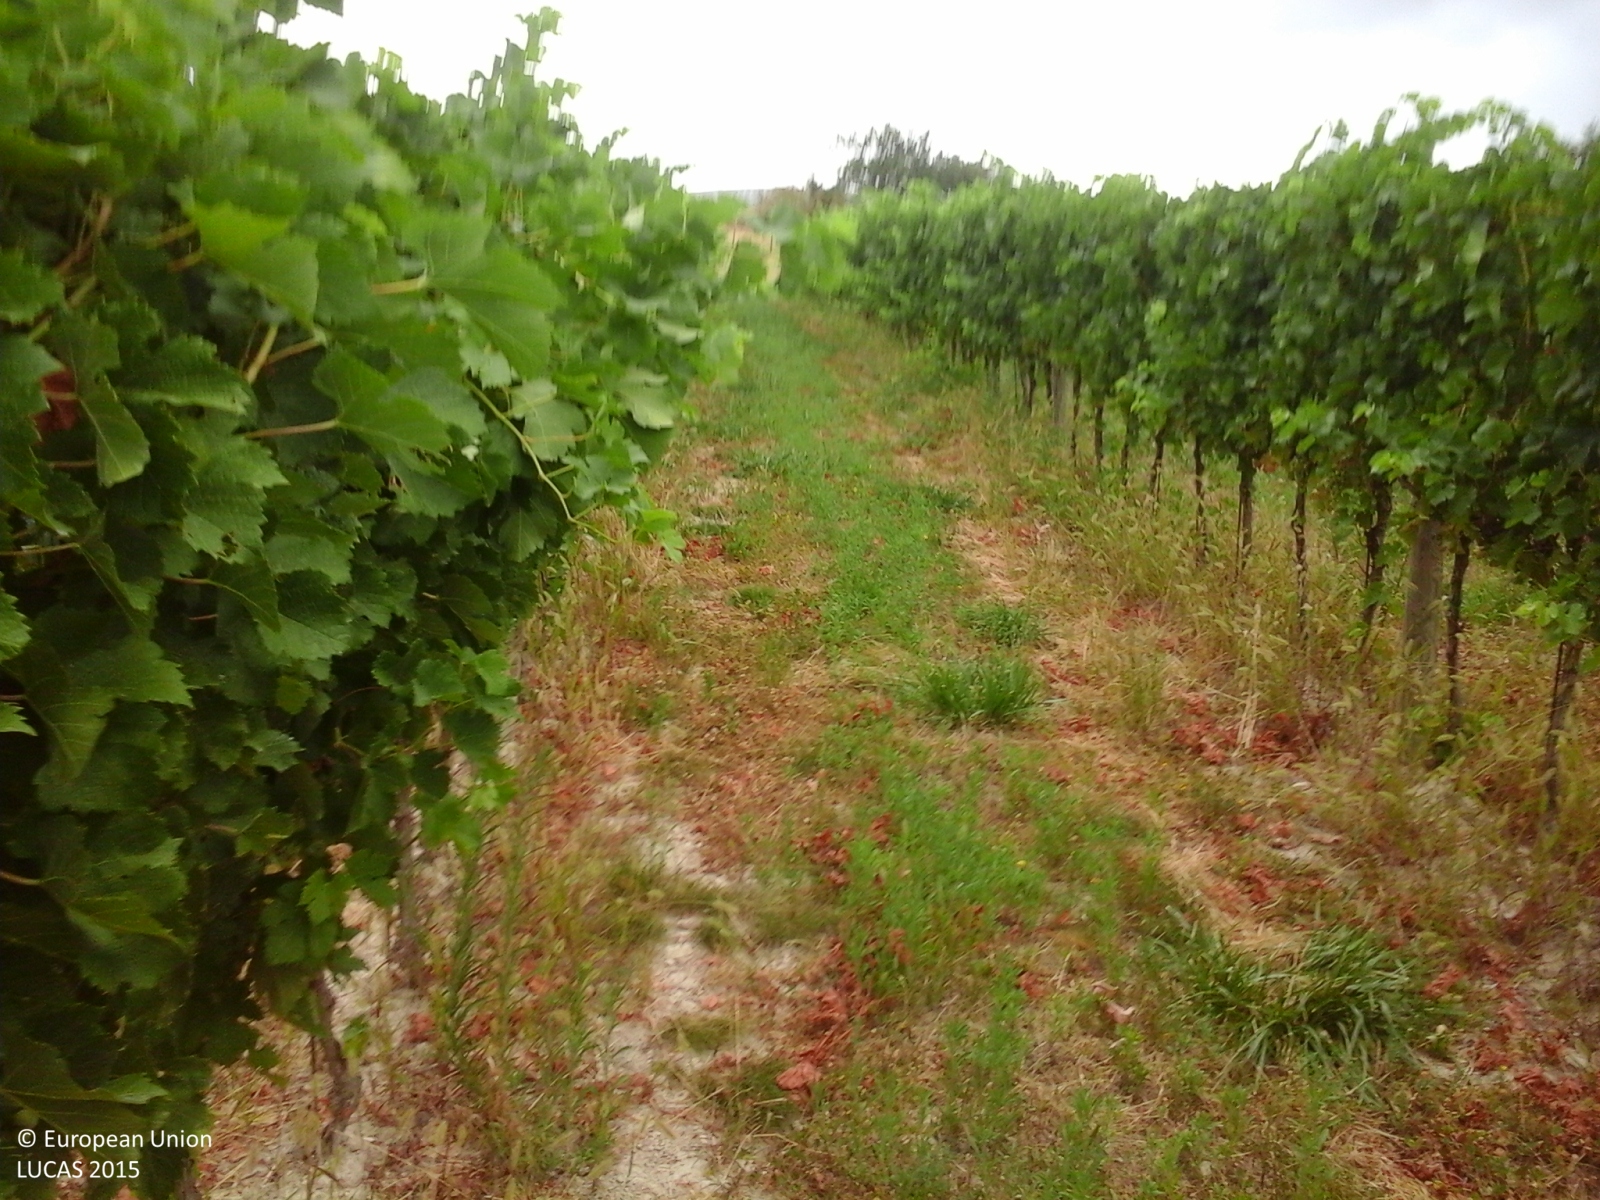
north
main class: Cropland
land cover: Vineyards
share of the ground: 50 - 75 %
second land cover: Spontaneously vegetated surfaces
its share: 50 - 75 %
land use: Agriculture (excluding fallow land and kitchen gardens)
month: July
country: IT
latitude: 43.2718
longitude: 13.2074
